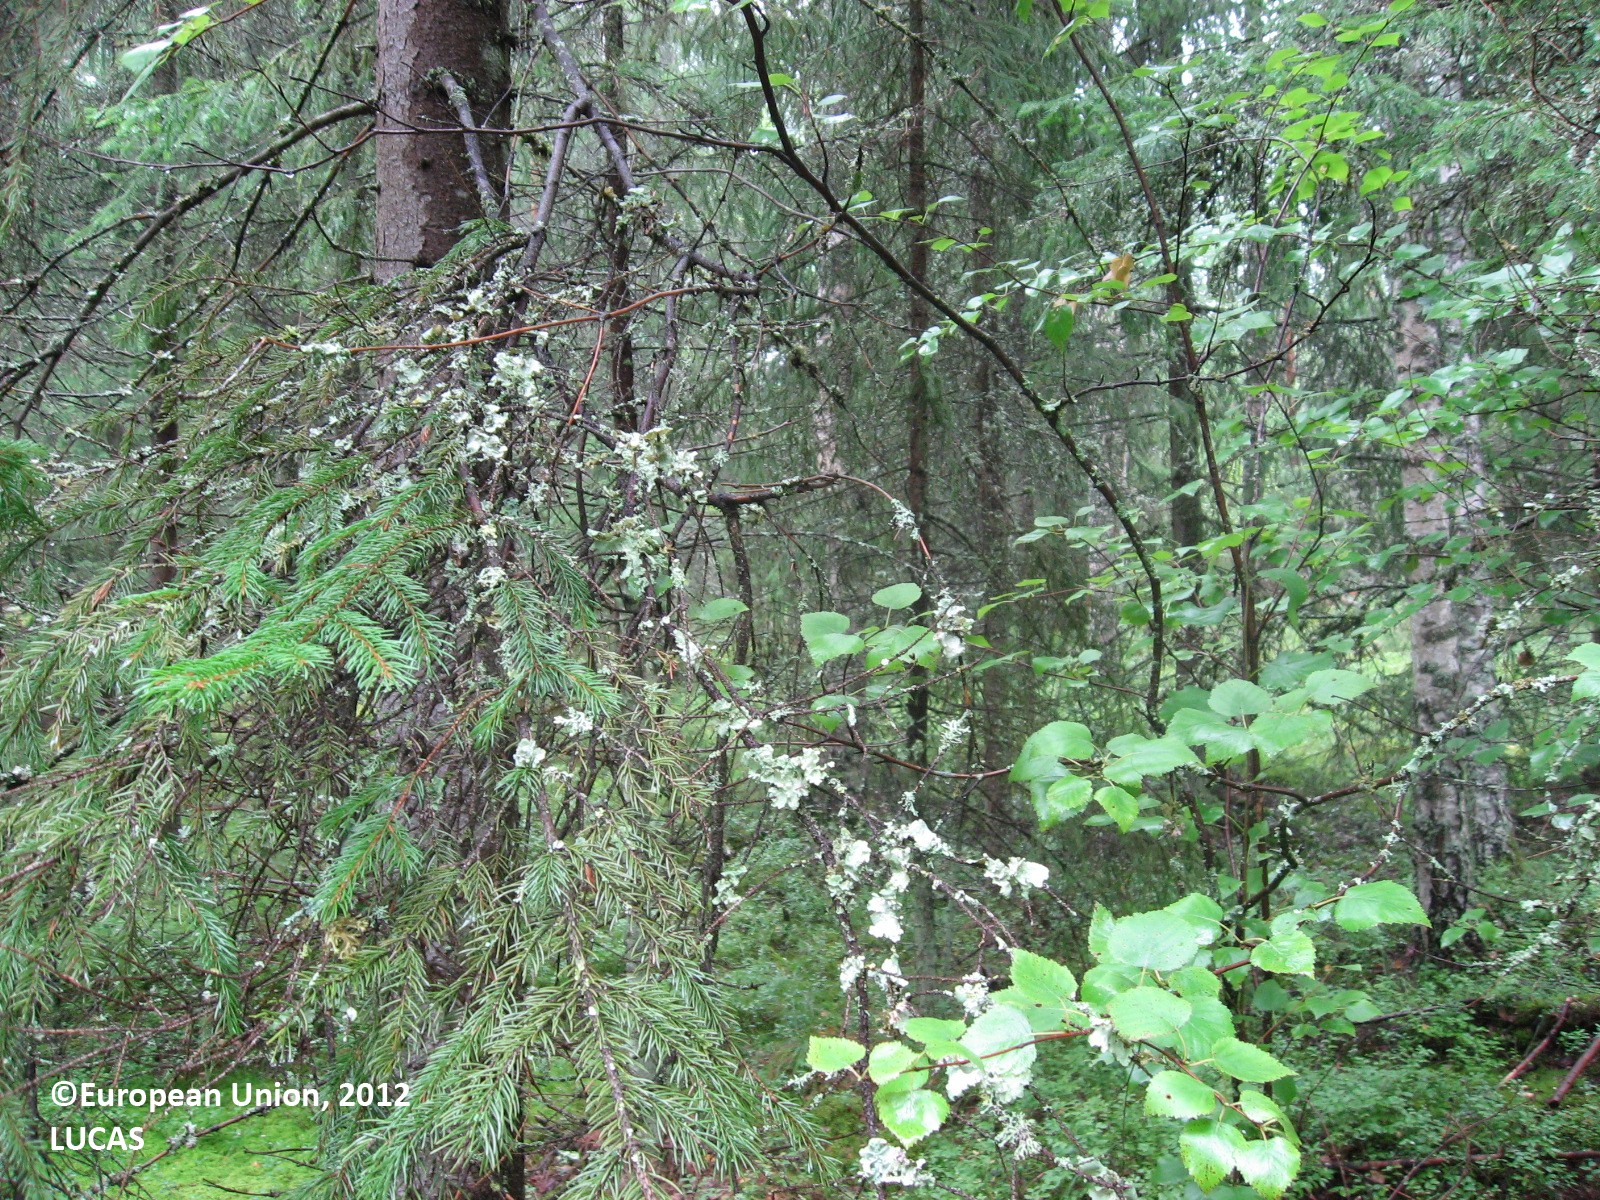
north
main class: Woodland
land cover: Spruce dominated coniferous woodland
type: boreal forest
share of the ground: > 75 %
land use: Forestry
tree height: > 5 m
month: August
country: FI
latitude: 60.5317
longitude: 25.4911
